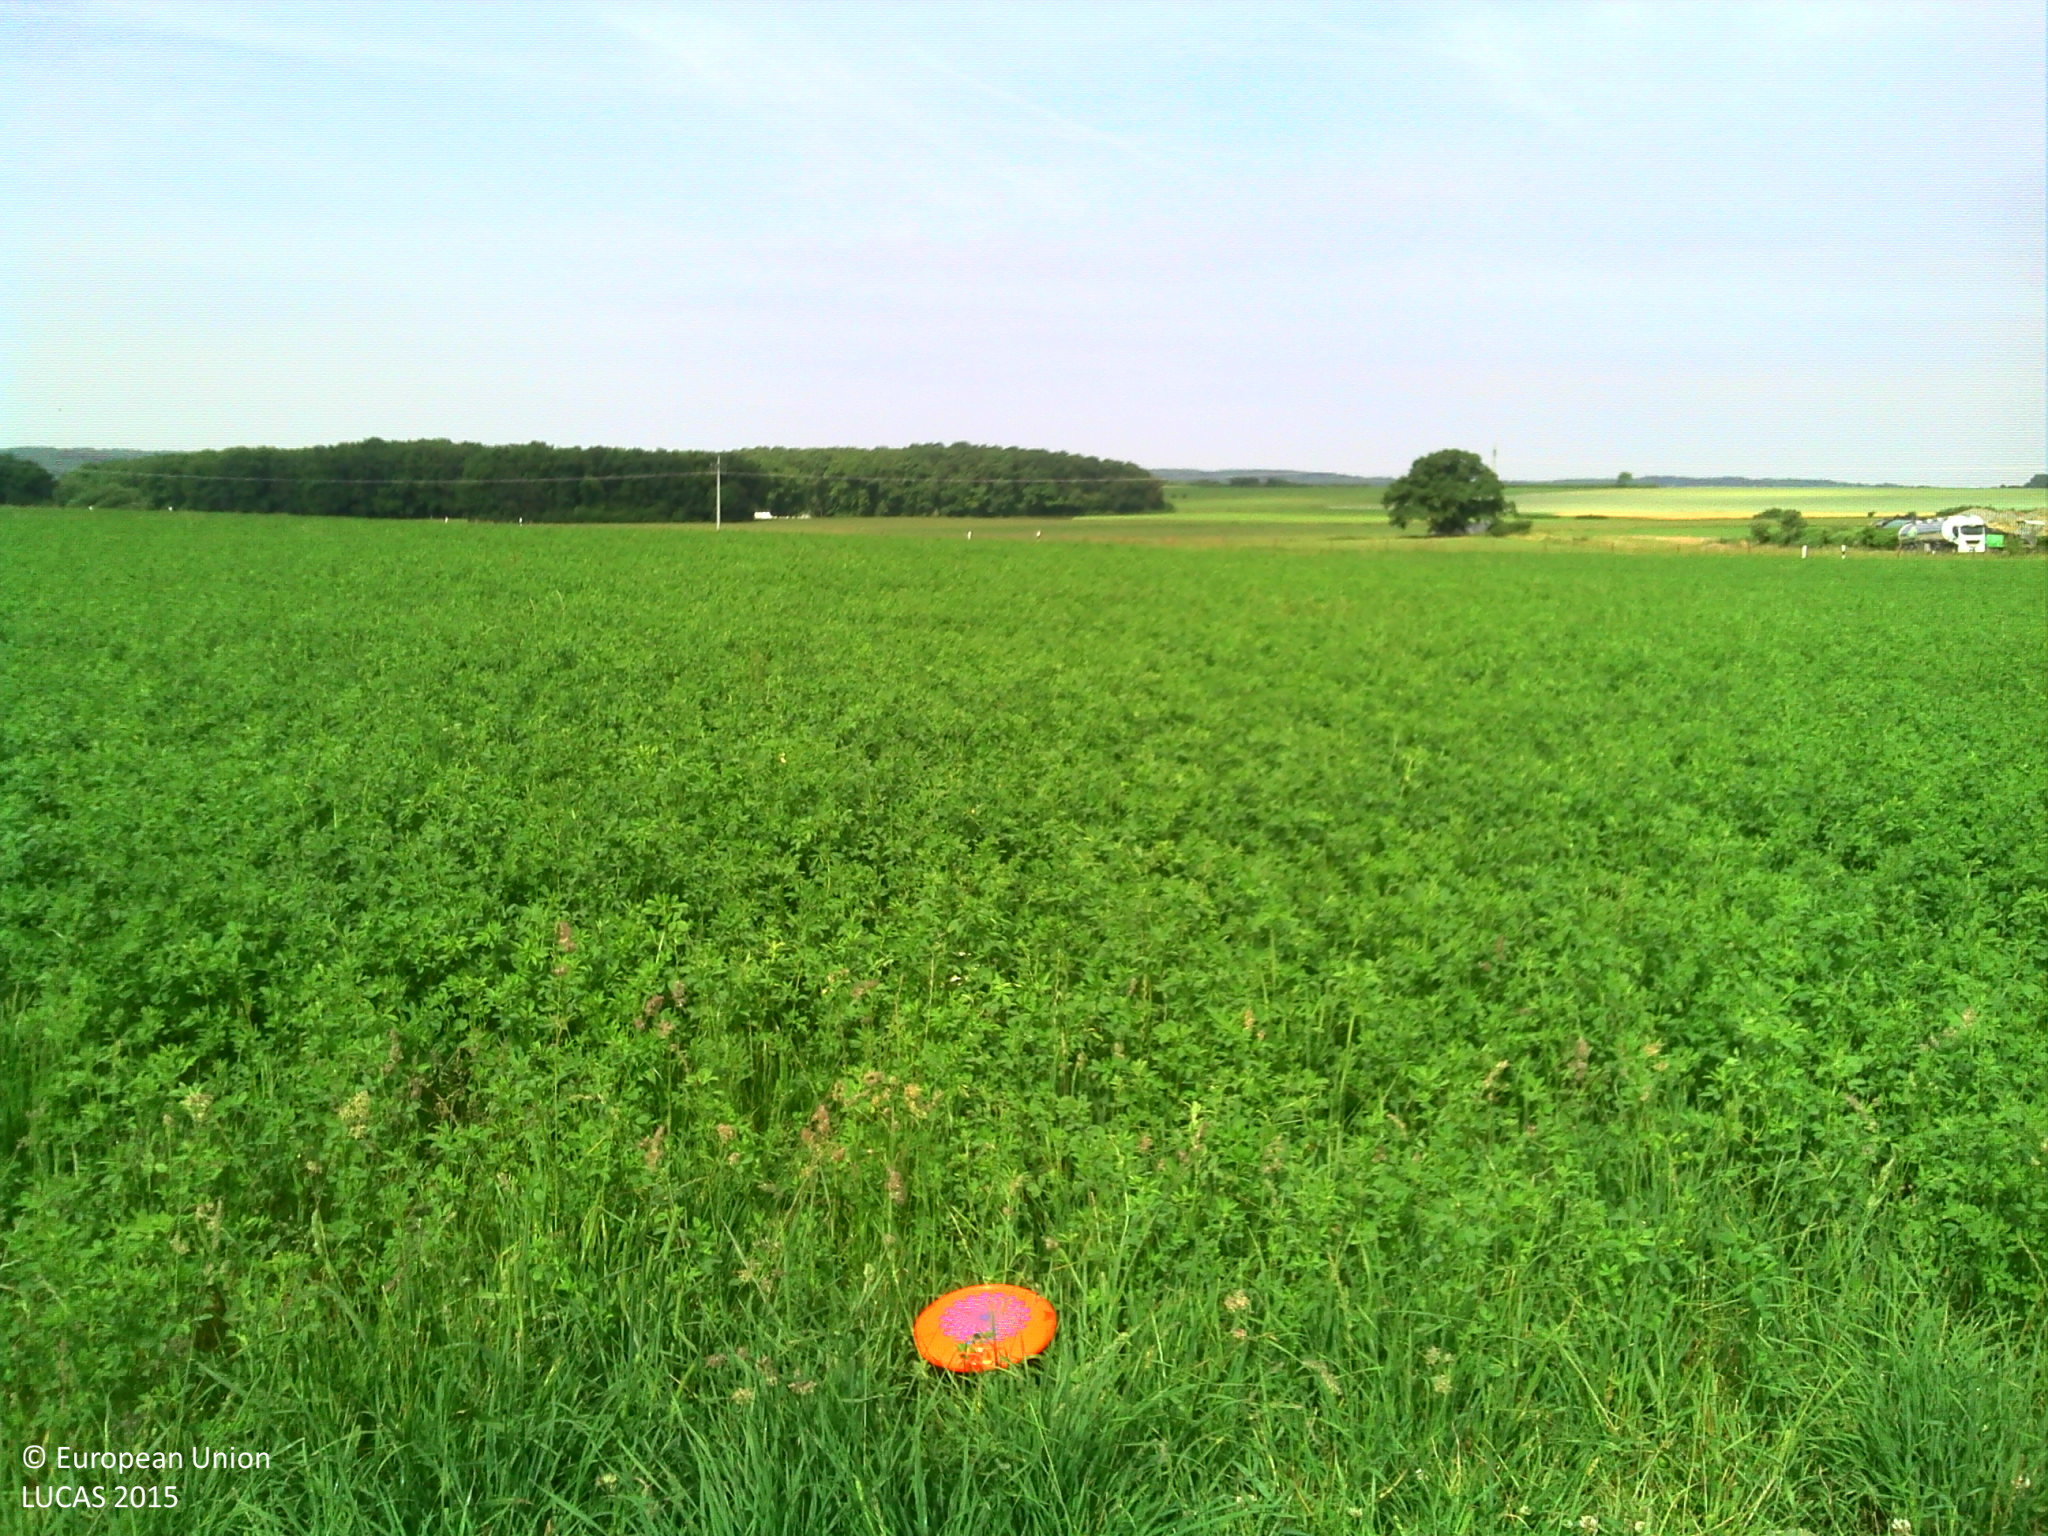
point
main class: Cropland
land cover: Common wheat
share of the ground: > 75 %
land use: Agriculture (excluding fallow land and kitchen gardens)
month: June
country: LU
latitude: 49.7810
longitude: 6.2637
